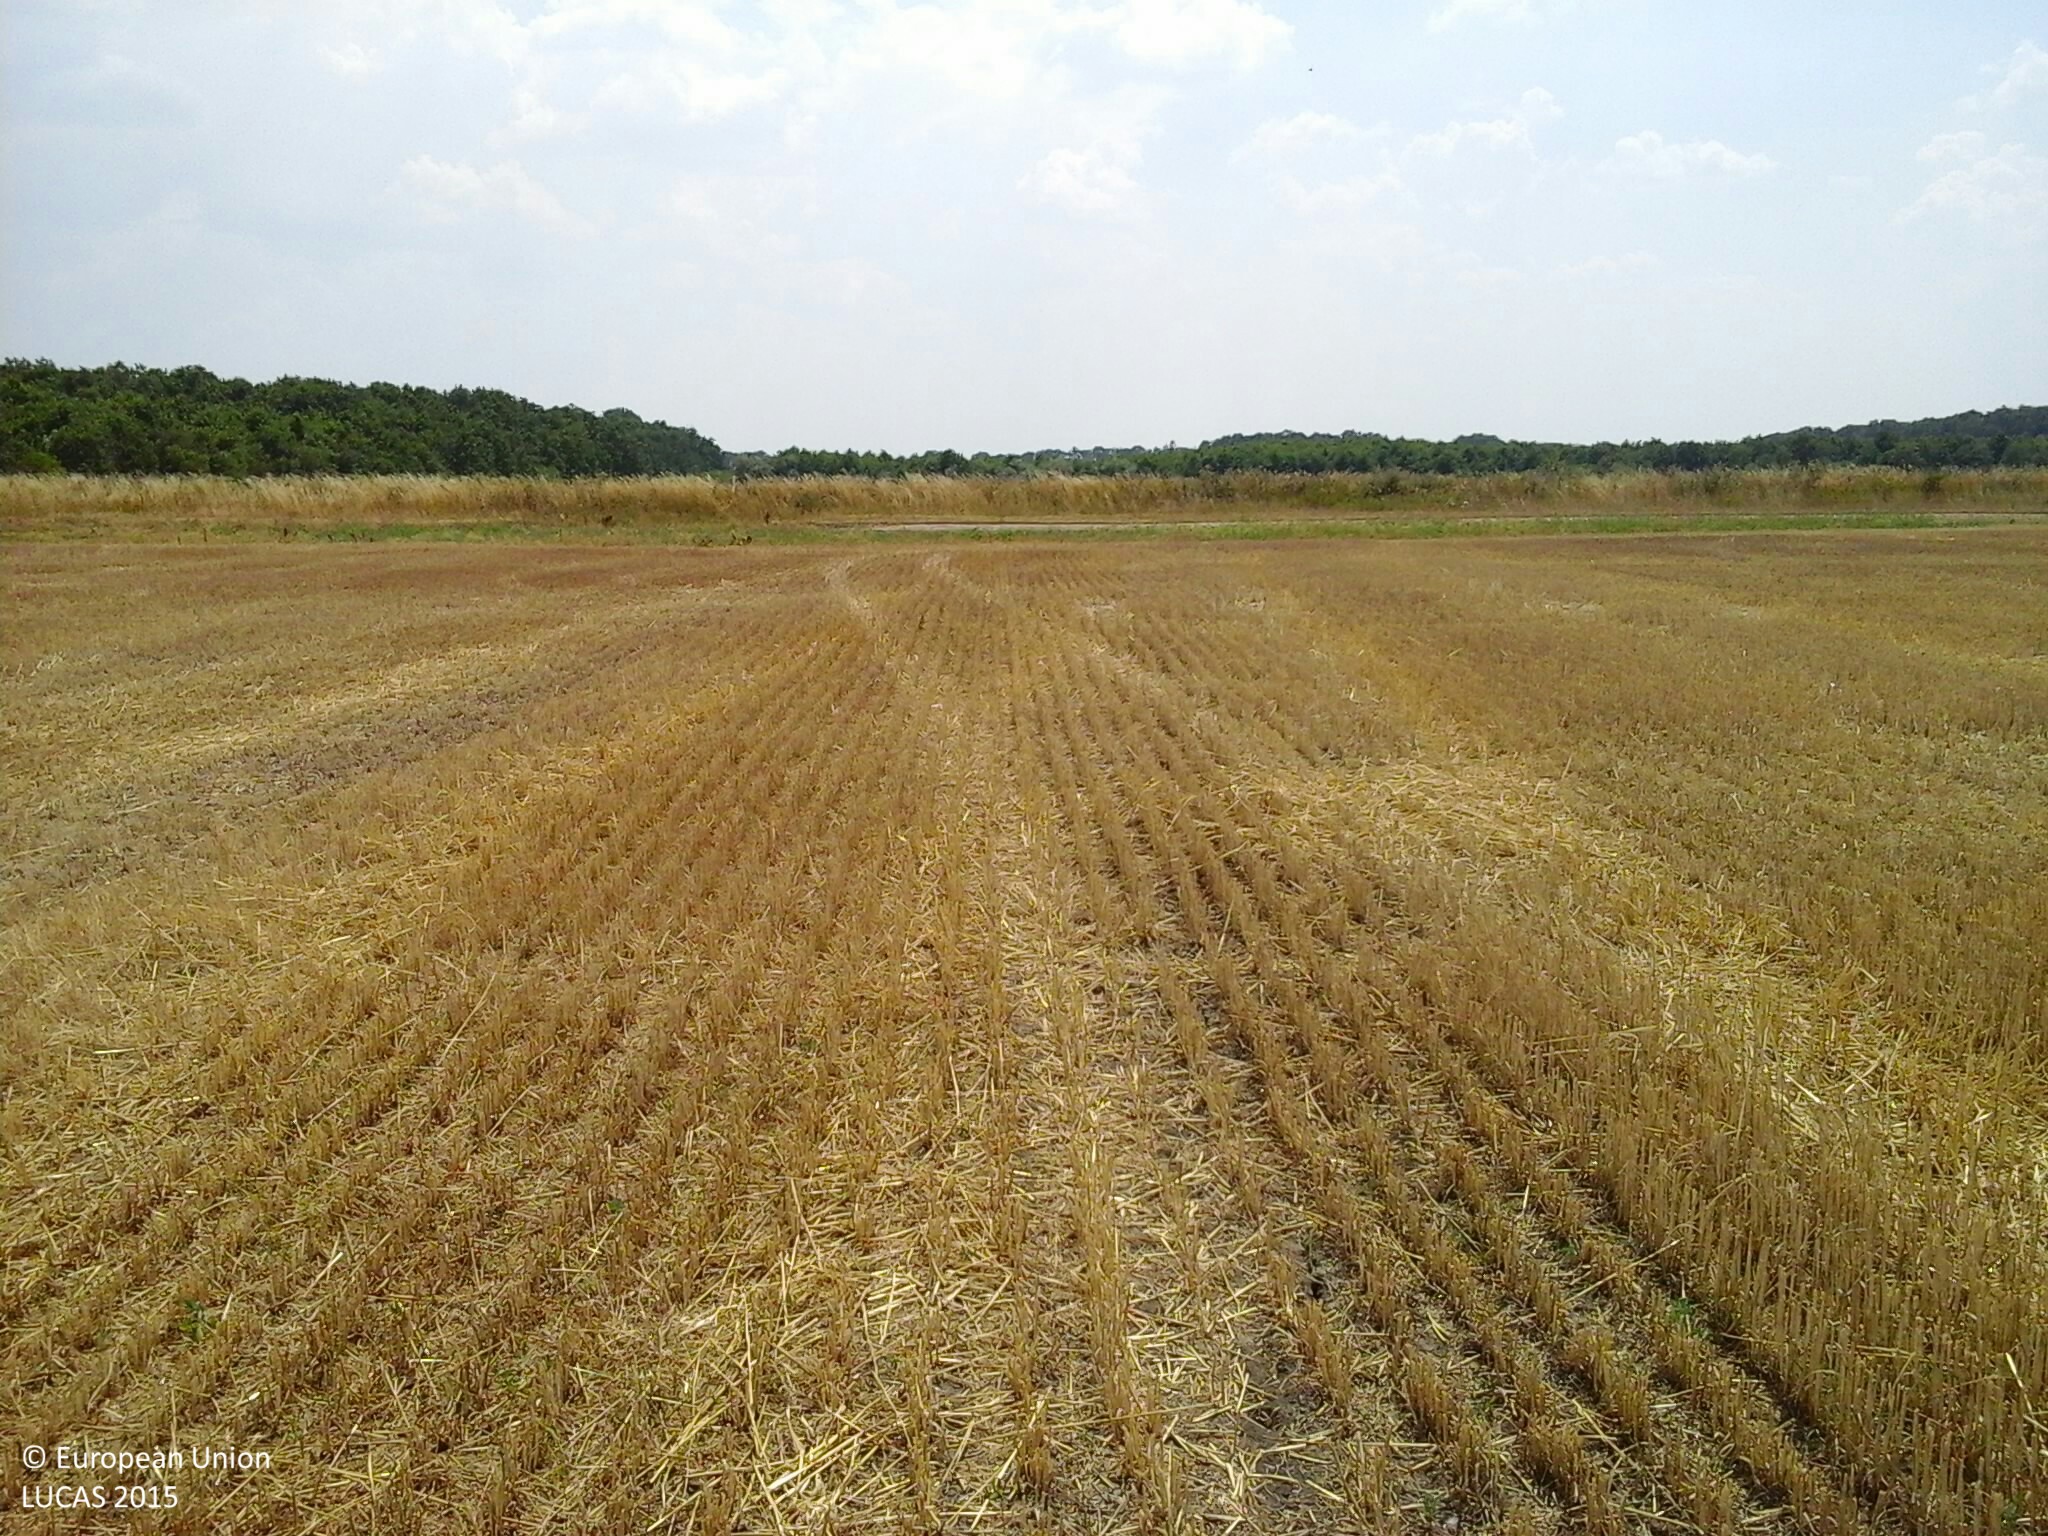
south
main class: Cropland
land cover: Common wheat
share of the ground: 25 - 50 %
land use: Agriculture (excluding fallow land and kitchen gardens)
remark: Harvested field
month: July
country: HU
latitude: 47.7016
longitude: 21.0590
